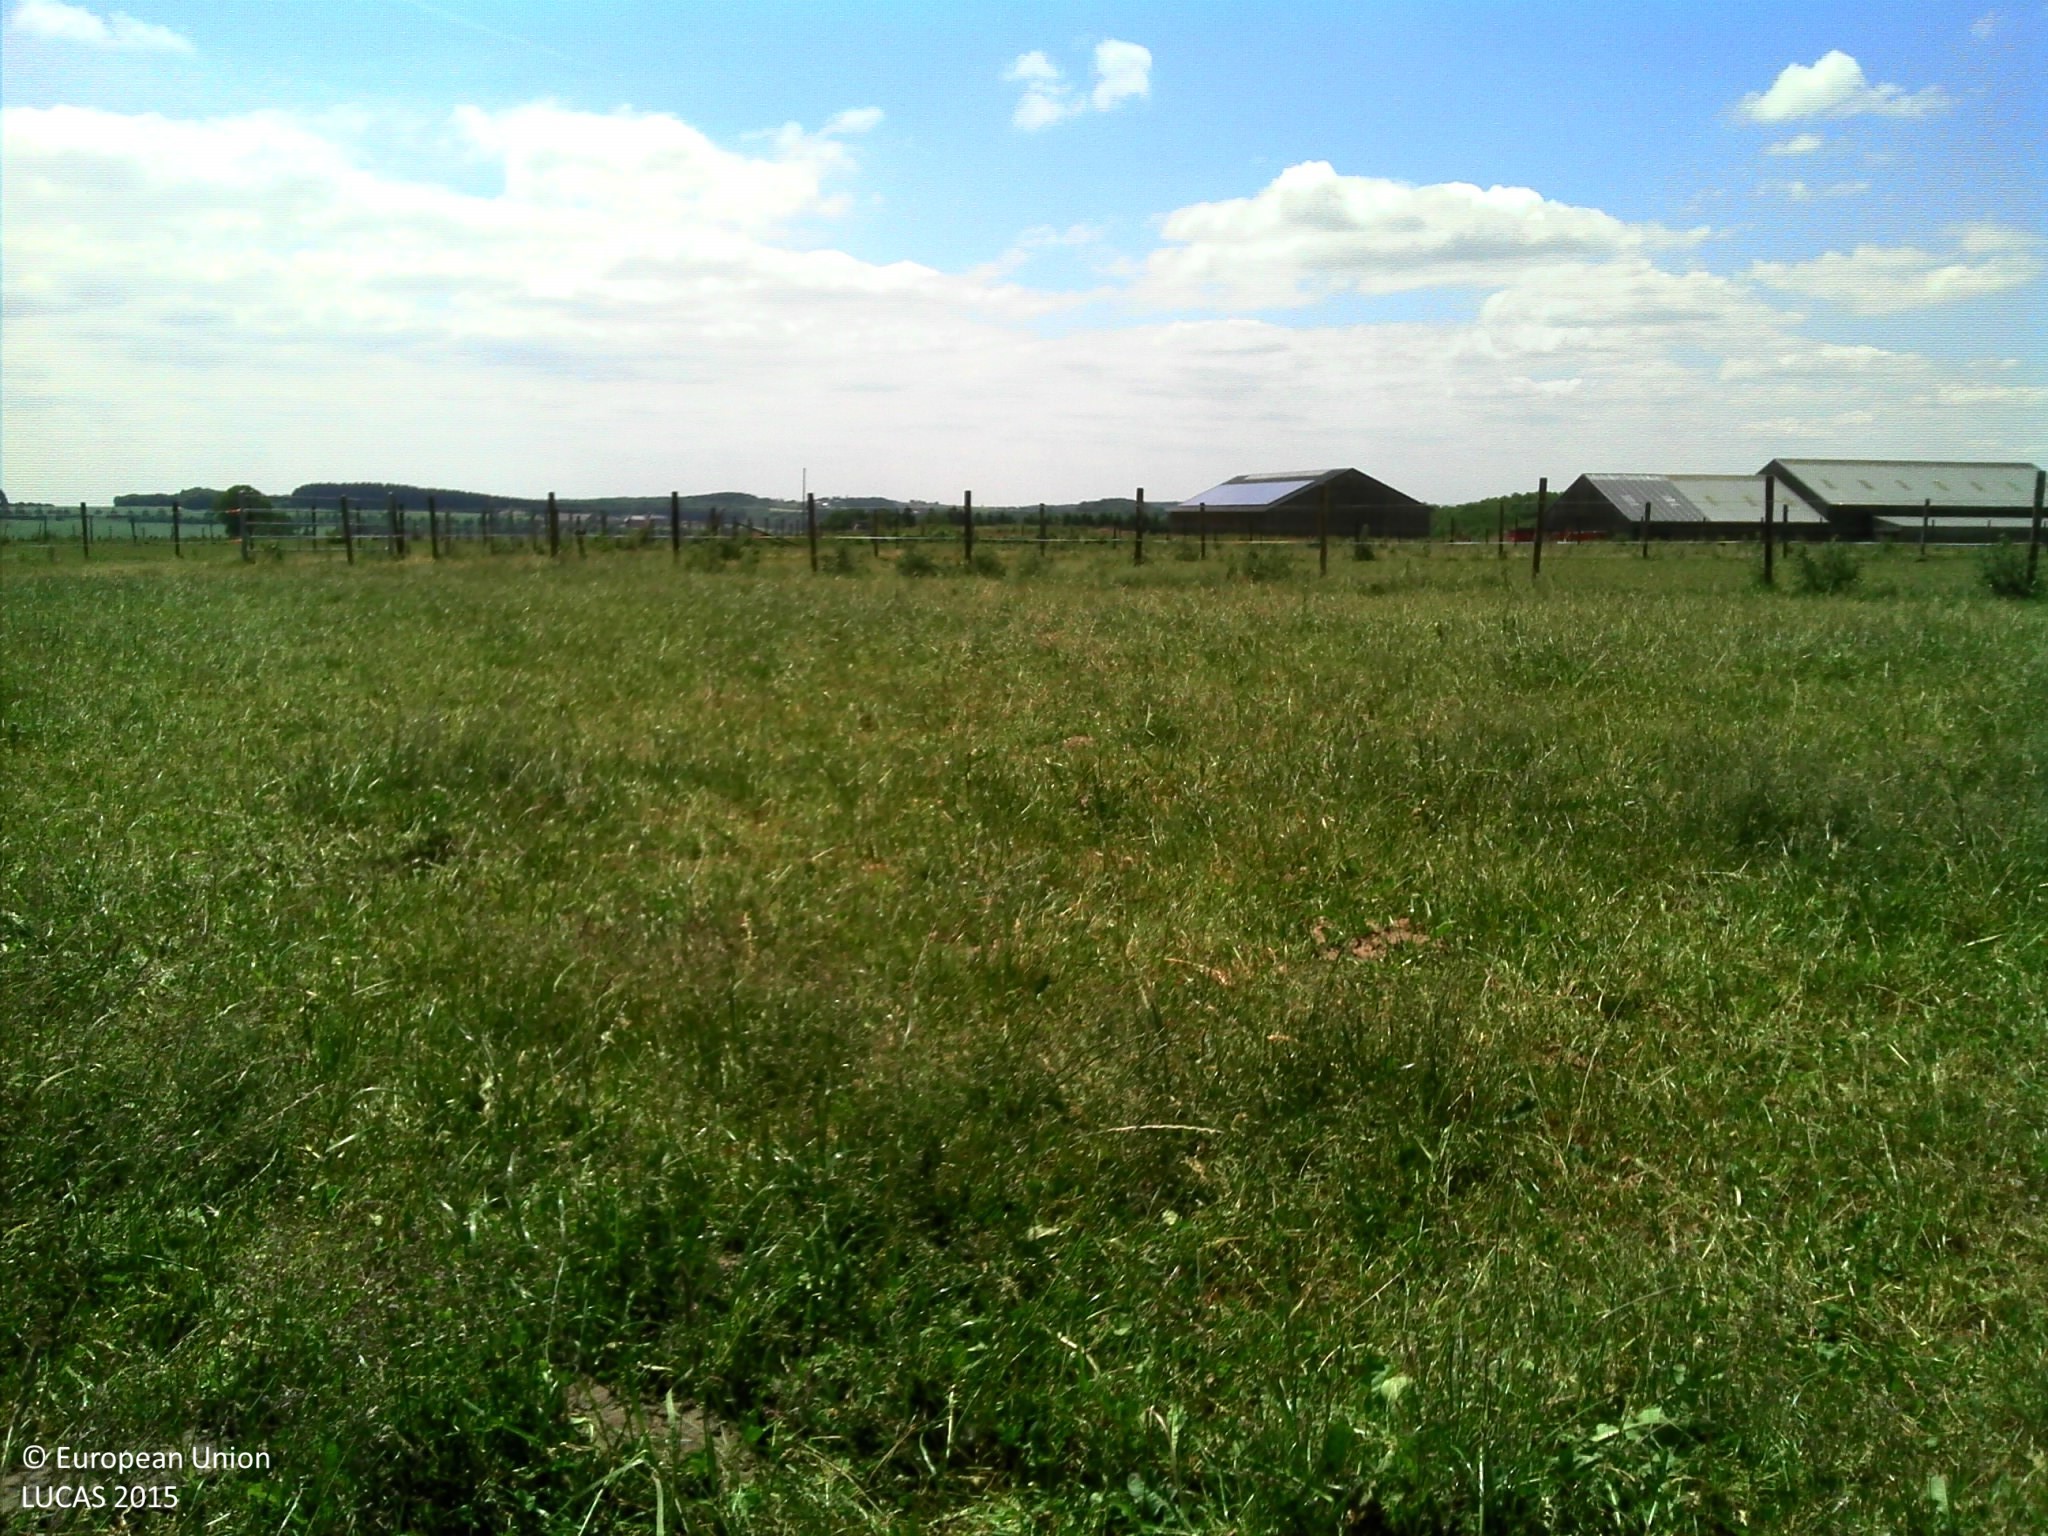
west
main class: Grassland
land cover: Grassland without tree/shrub cover
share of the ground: > 75 %
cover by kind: herbaceous plants 100 %
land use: Agriculture (excluding fallow land and kitchen gardens)
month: June
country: LU
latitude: 49.8783
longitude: 5.9496
